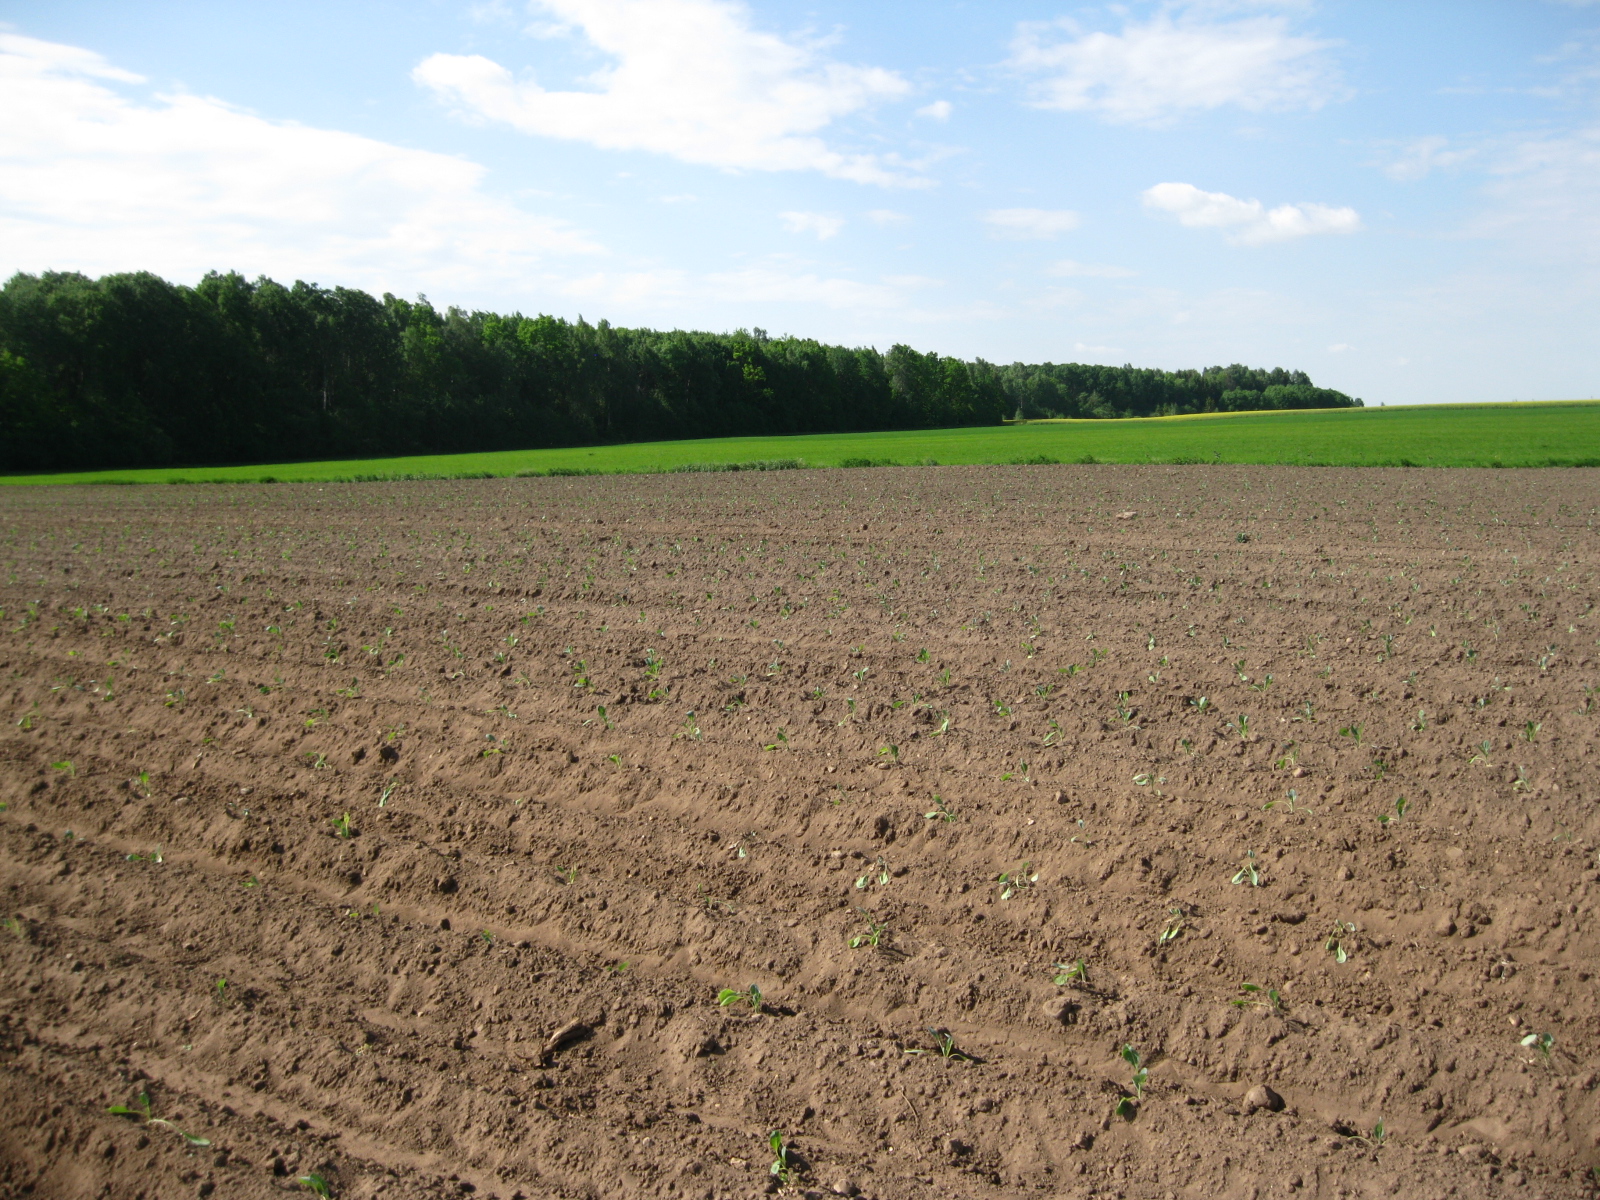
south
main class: Cropland
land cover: Other fresh vegetables
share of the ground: < 10 %
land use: Agriculture (excluding fallow land and kitchen gardens)
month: June
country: LT
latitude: 55.7829
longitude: 23.8132
